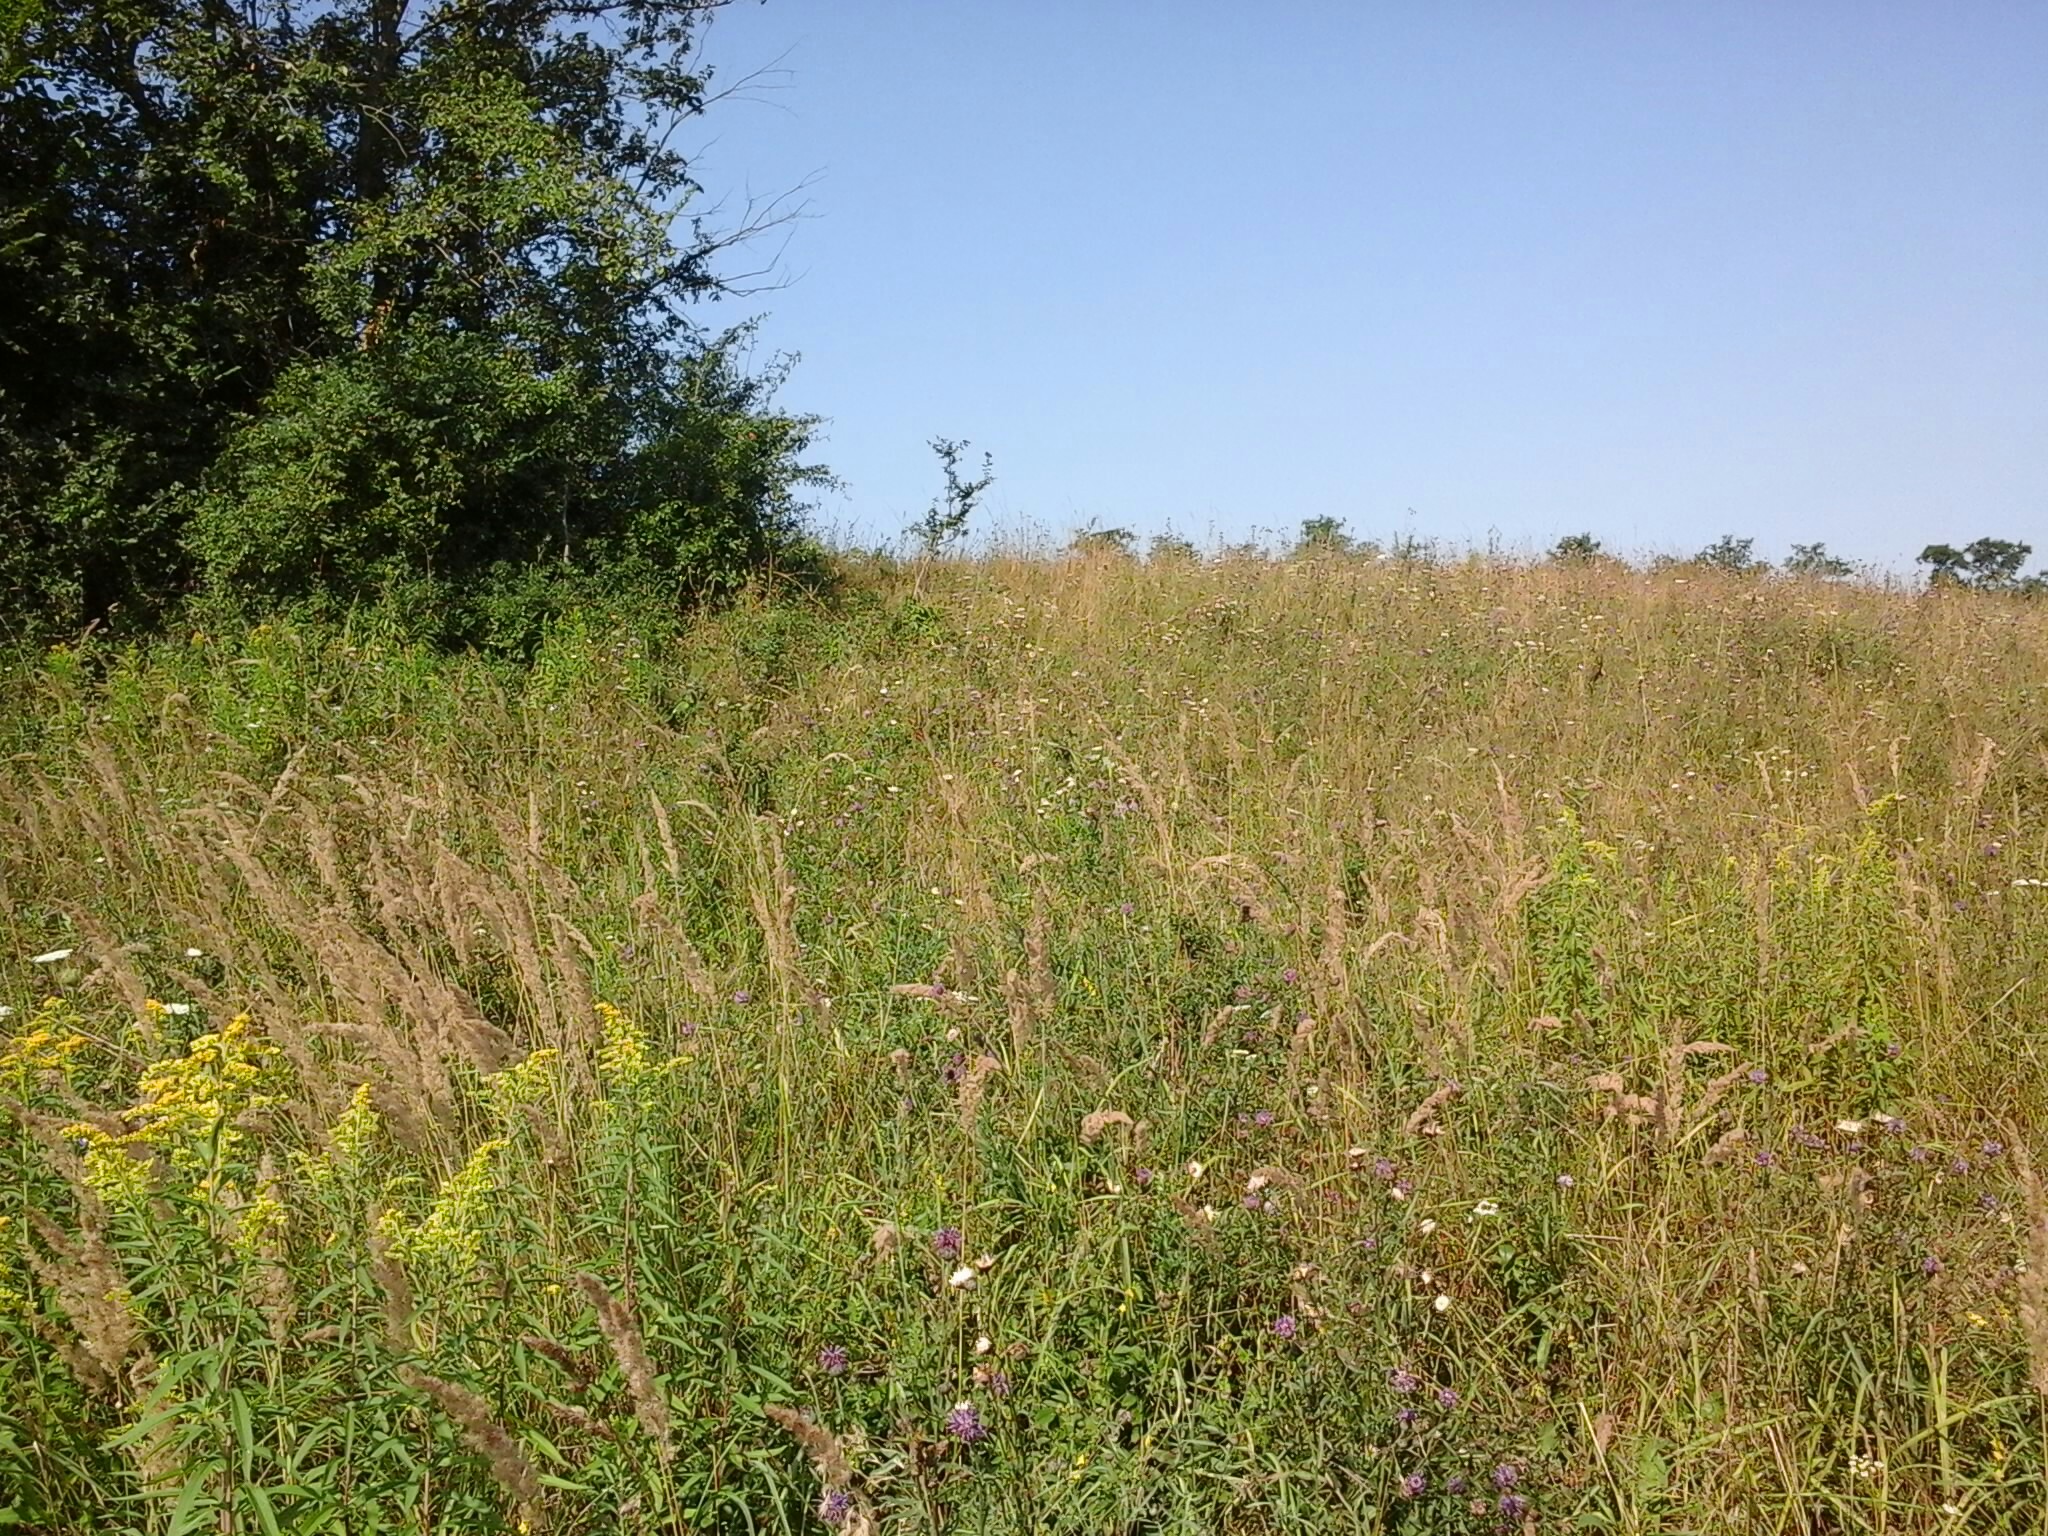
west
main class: Grassland
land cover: Grassland without tree/shrub cover
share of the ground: > 75 %
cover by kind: herbaceous plants 95 %, shrubs 5 %
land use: Agriculture (excluding fallow land and kitchen gardens)
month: August
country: HU
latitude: 47.4515
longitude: 17.9015
